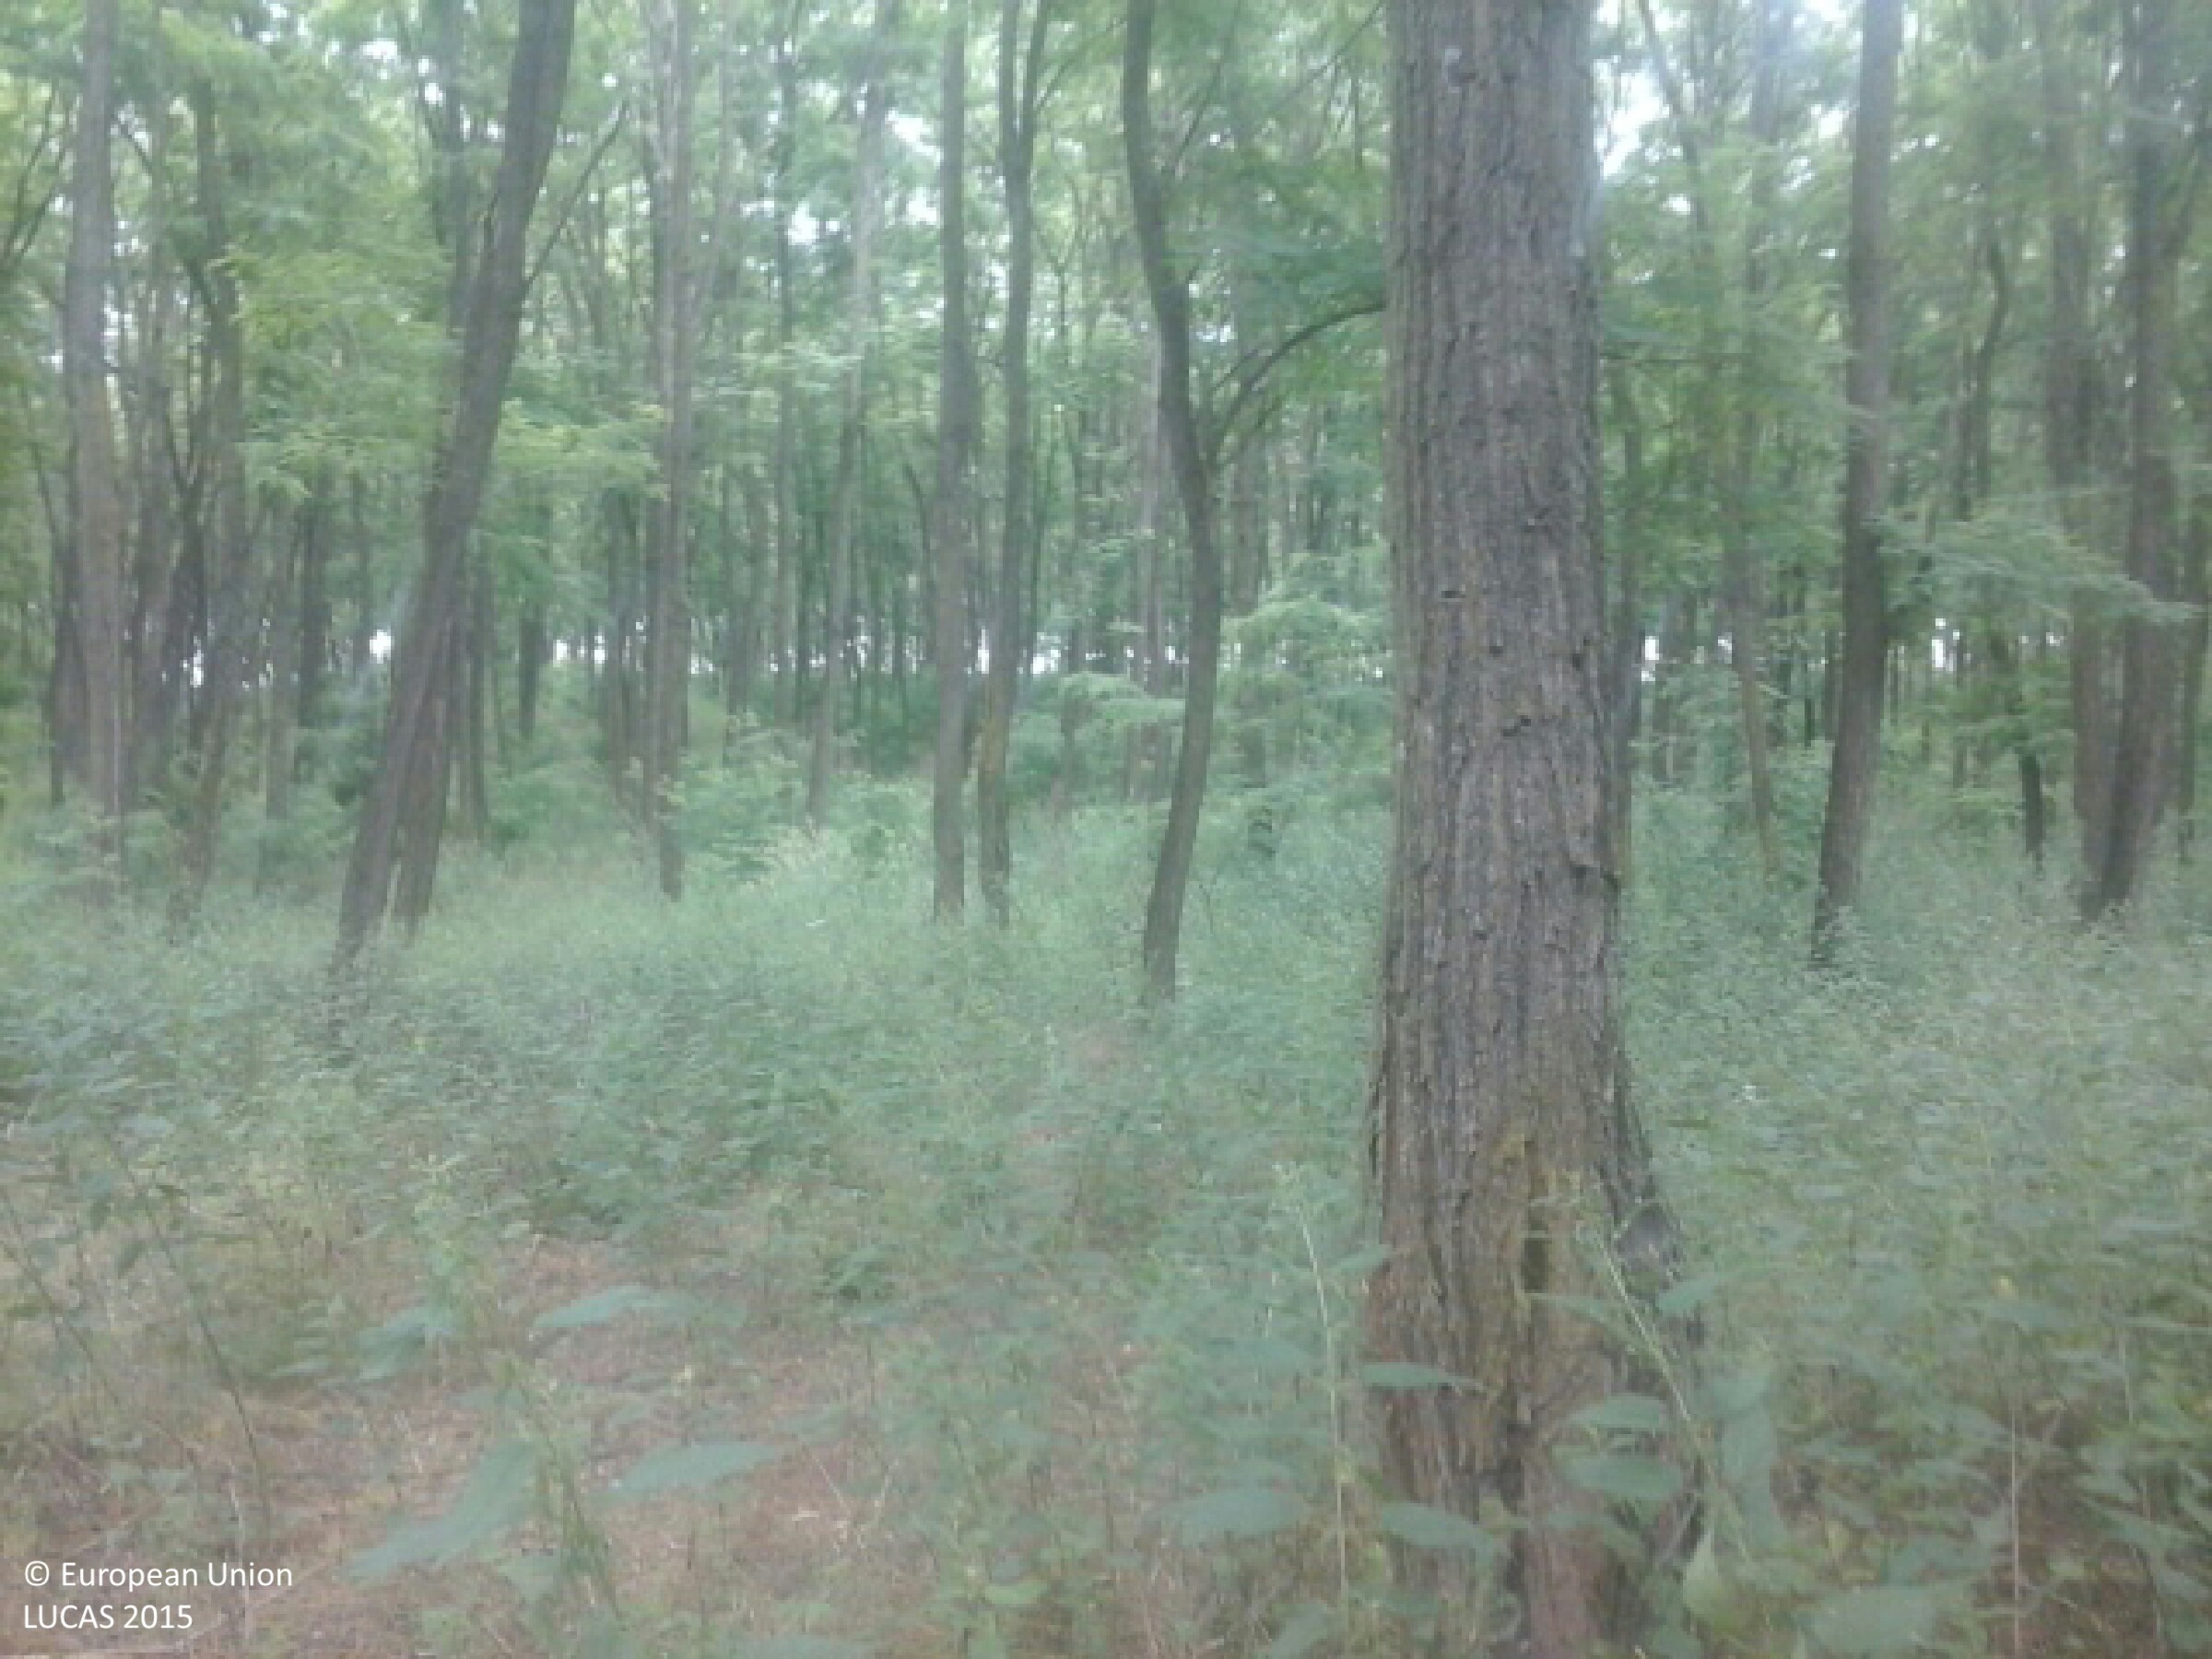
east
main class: Woodland
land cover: Broadleaved woodland
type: mesophytic deciduous forest
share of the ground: > 75 %
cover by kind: broadleaved forest trees 95 %, herbaceous plants 5 %
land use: Forestry
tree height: > 5 m
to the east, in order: Broadleaved woodland; Grass margins; Tracks; Grassland without tree/shrub cover
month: June
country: HU
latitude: 47.9465
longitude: 22.1712
